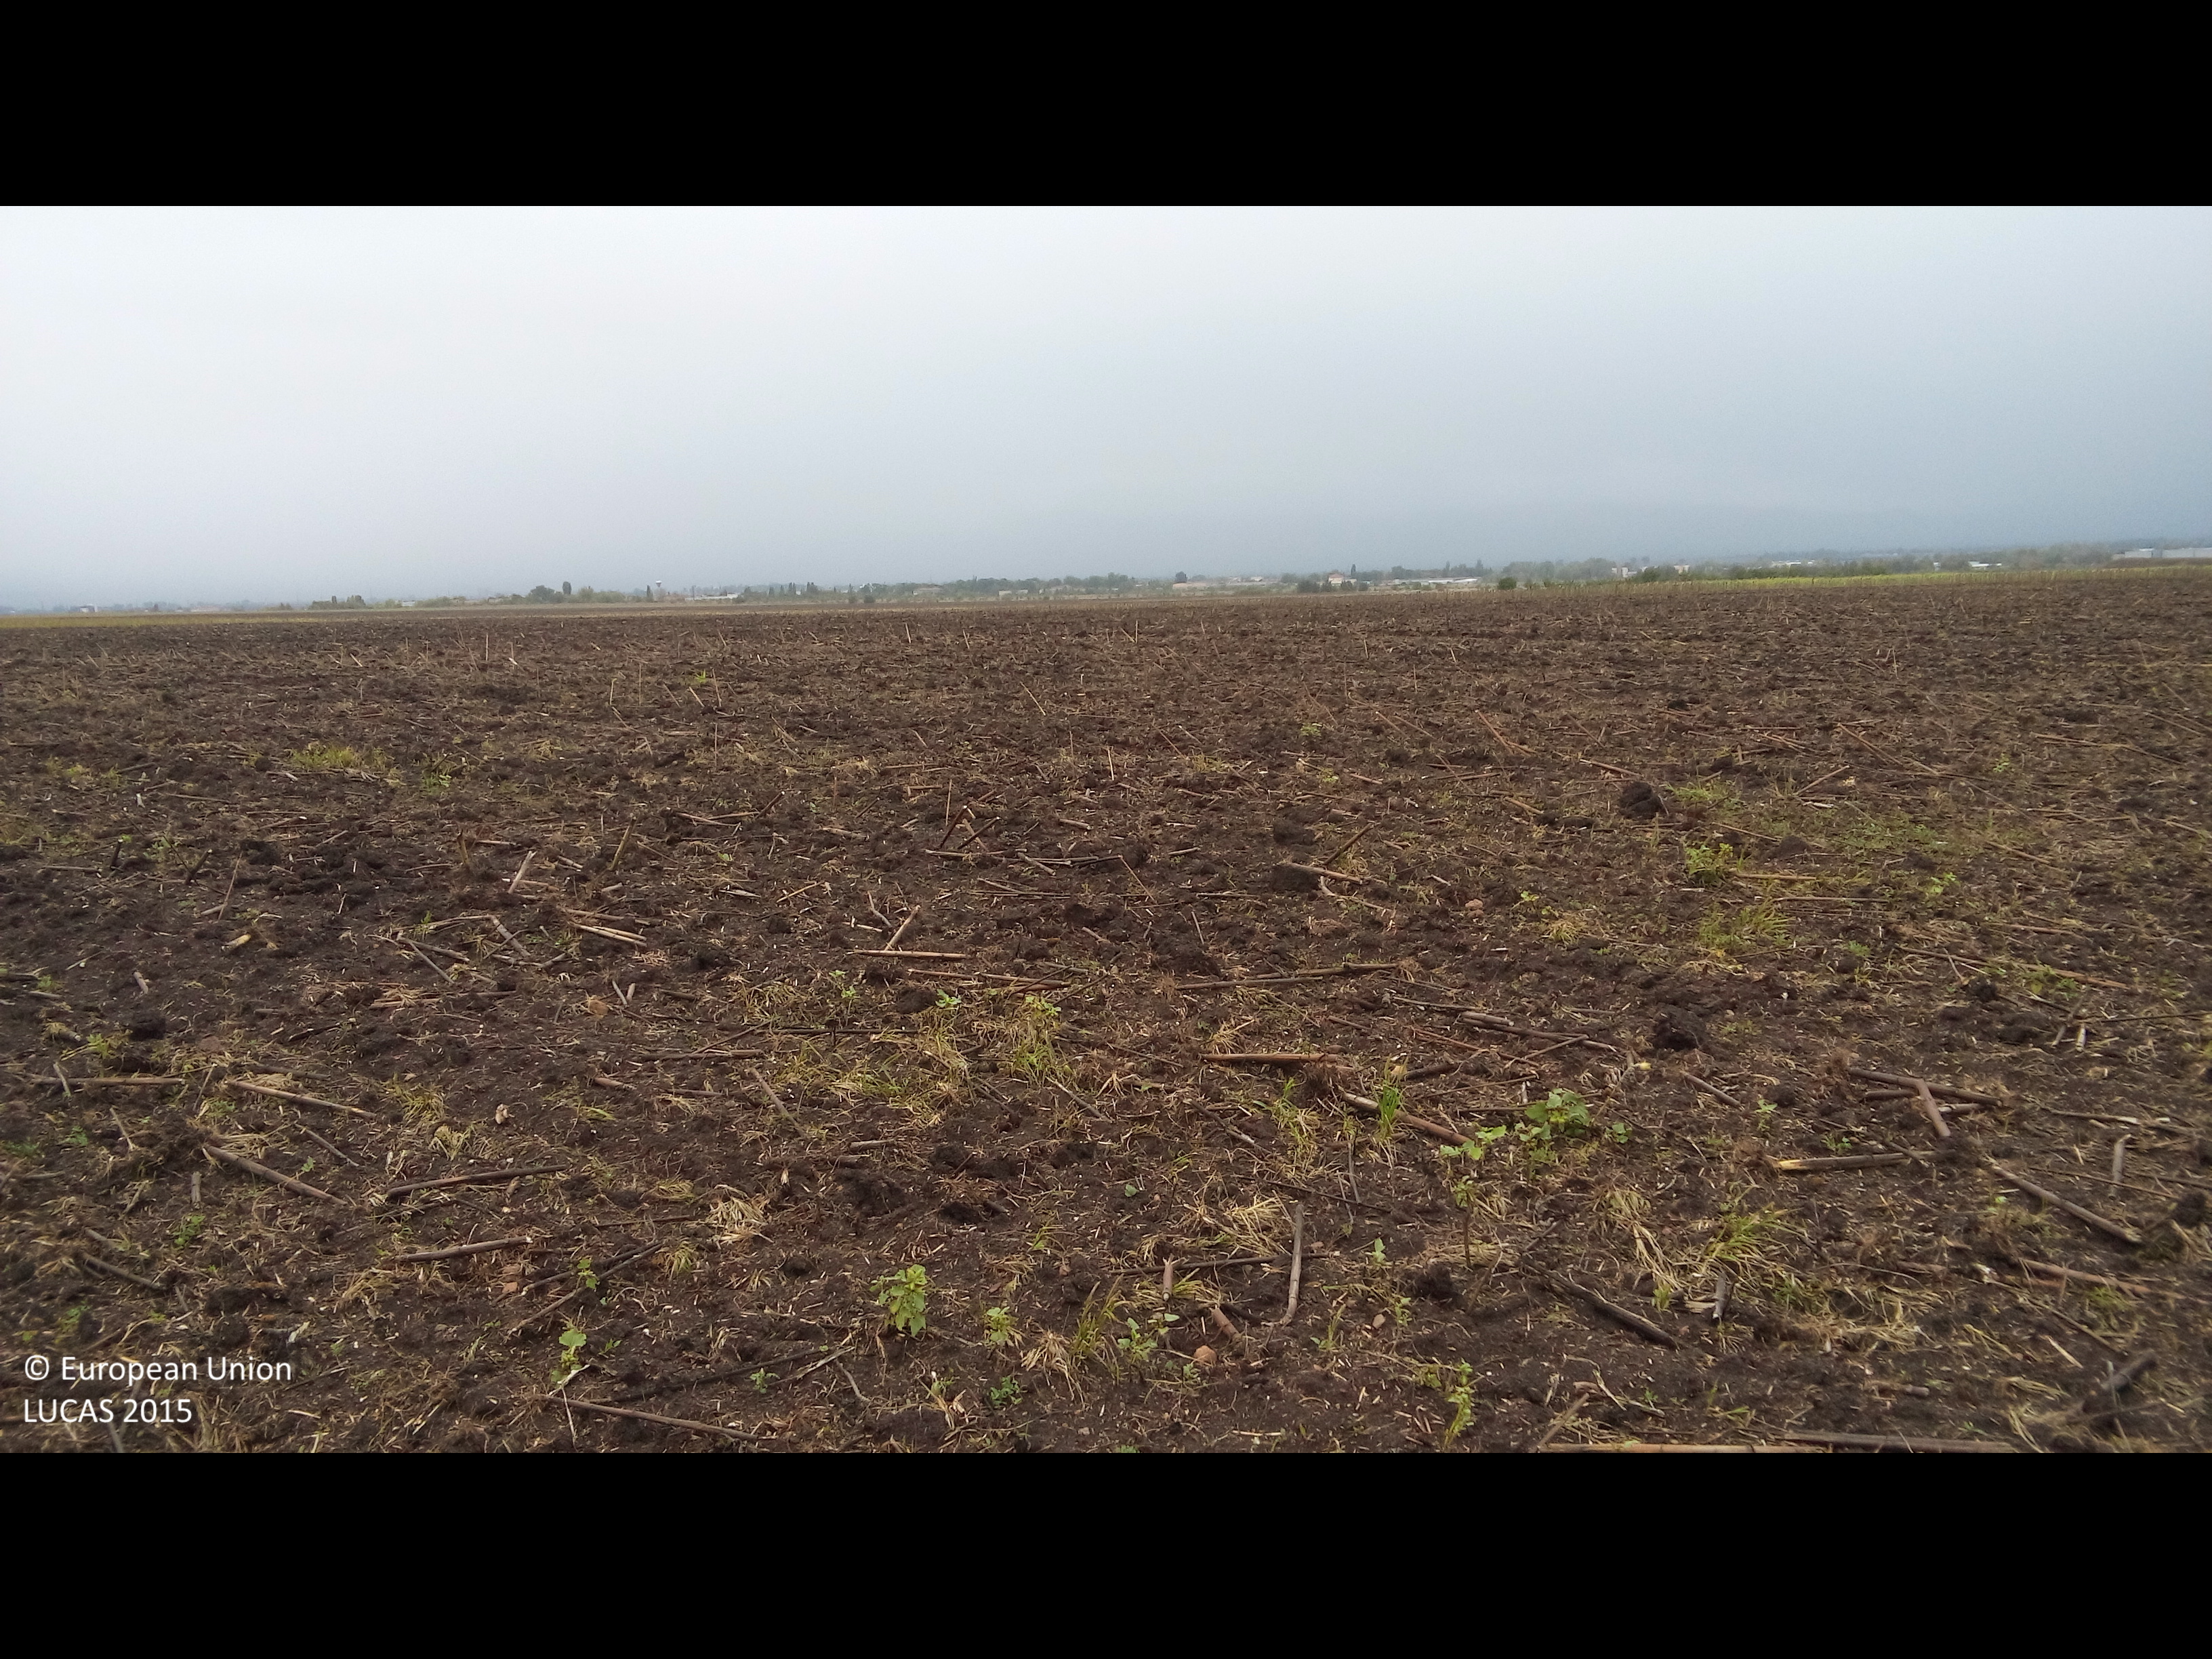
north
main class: Cropland
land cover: Sunflower
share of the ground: 10 - 25 %
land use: Agriculture (excluding fallow land and kitchen gardens)
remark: Harvested field
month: September
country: BG
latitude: 42.7376
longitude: 23.1882
